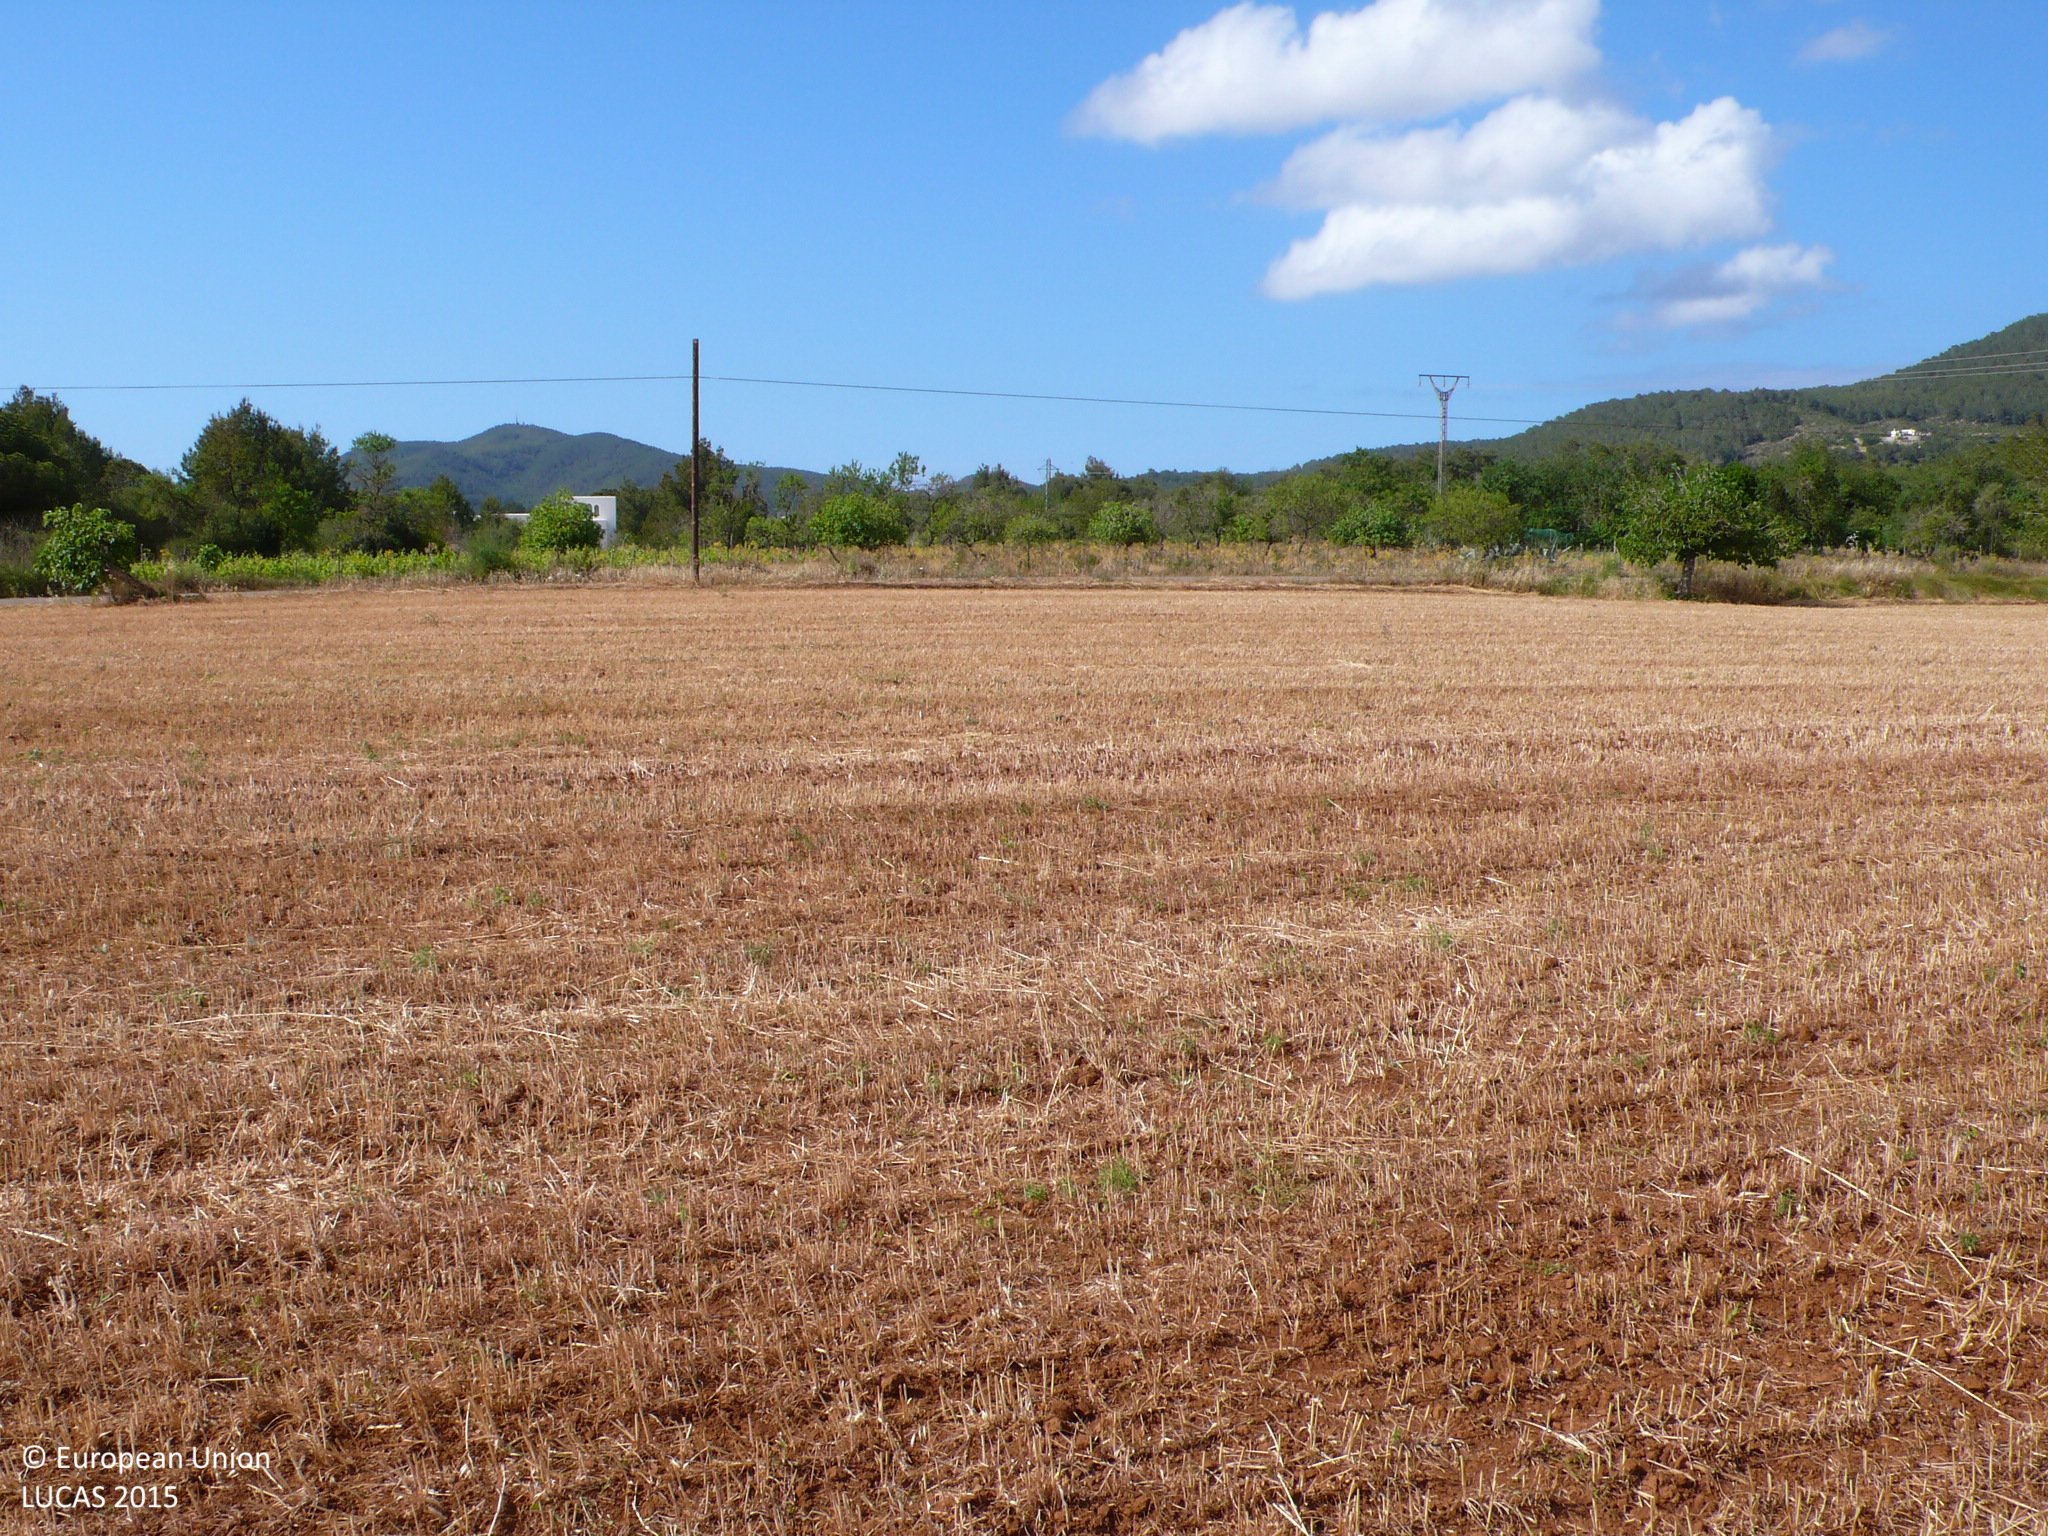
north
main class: Cropland
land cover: Oats
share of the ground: < 10 %
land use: Agriculture (excluding fallow land and kitchen gardens)
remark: Harvested field
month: May
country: ES
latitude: 39.0423
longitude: 1.4966
